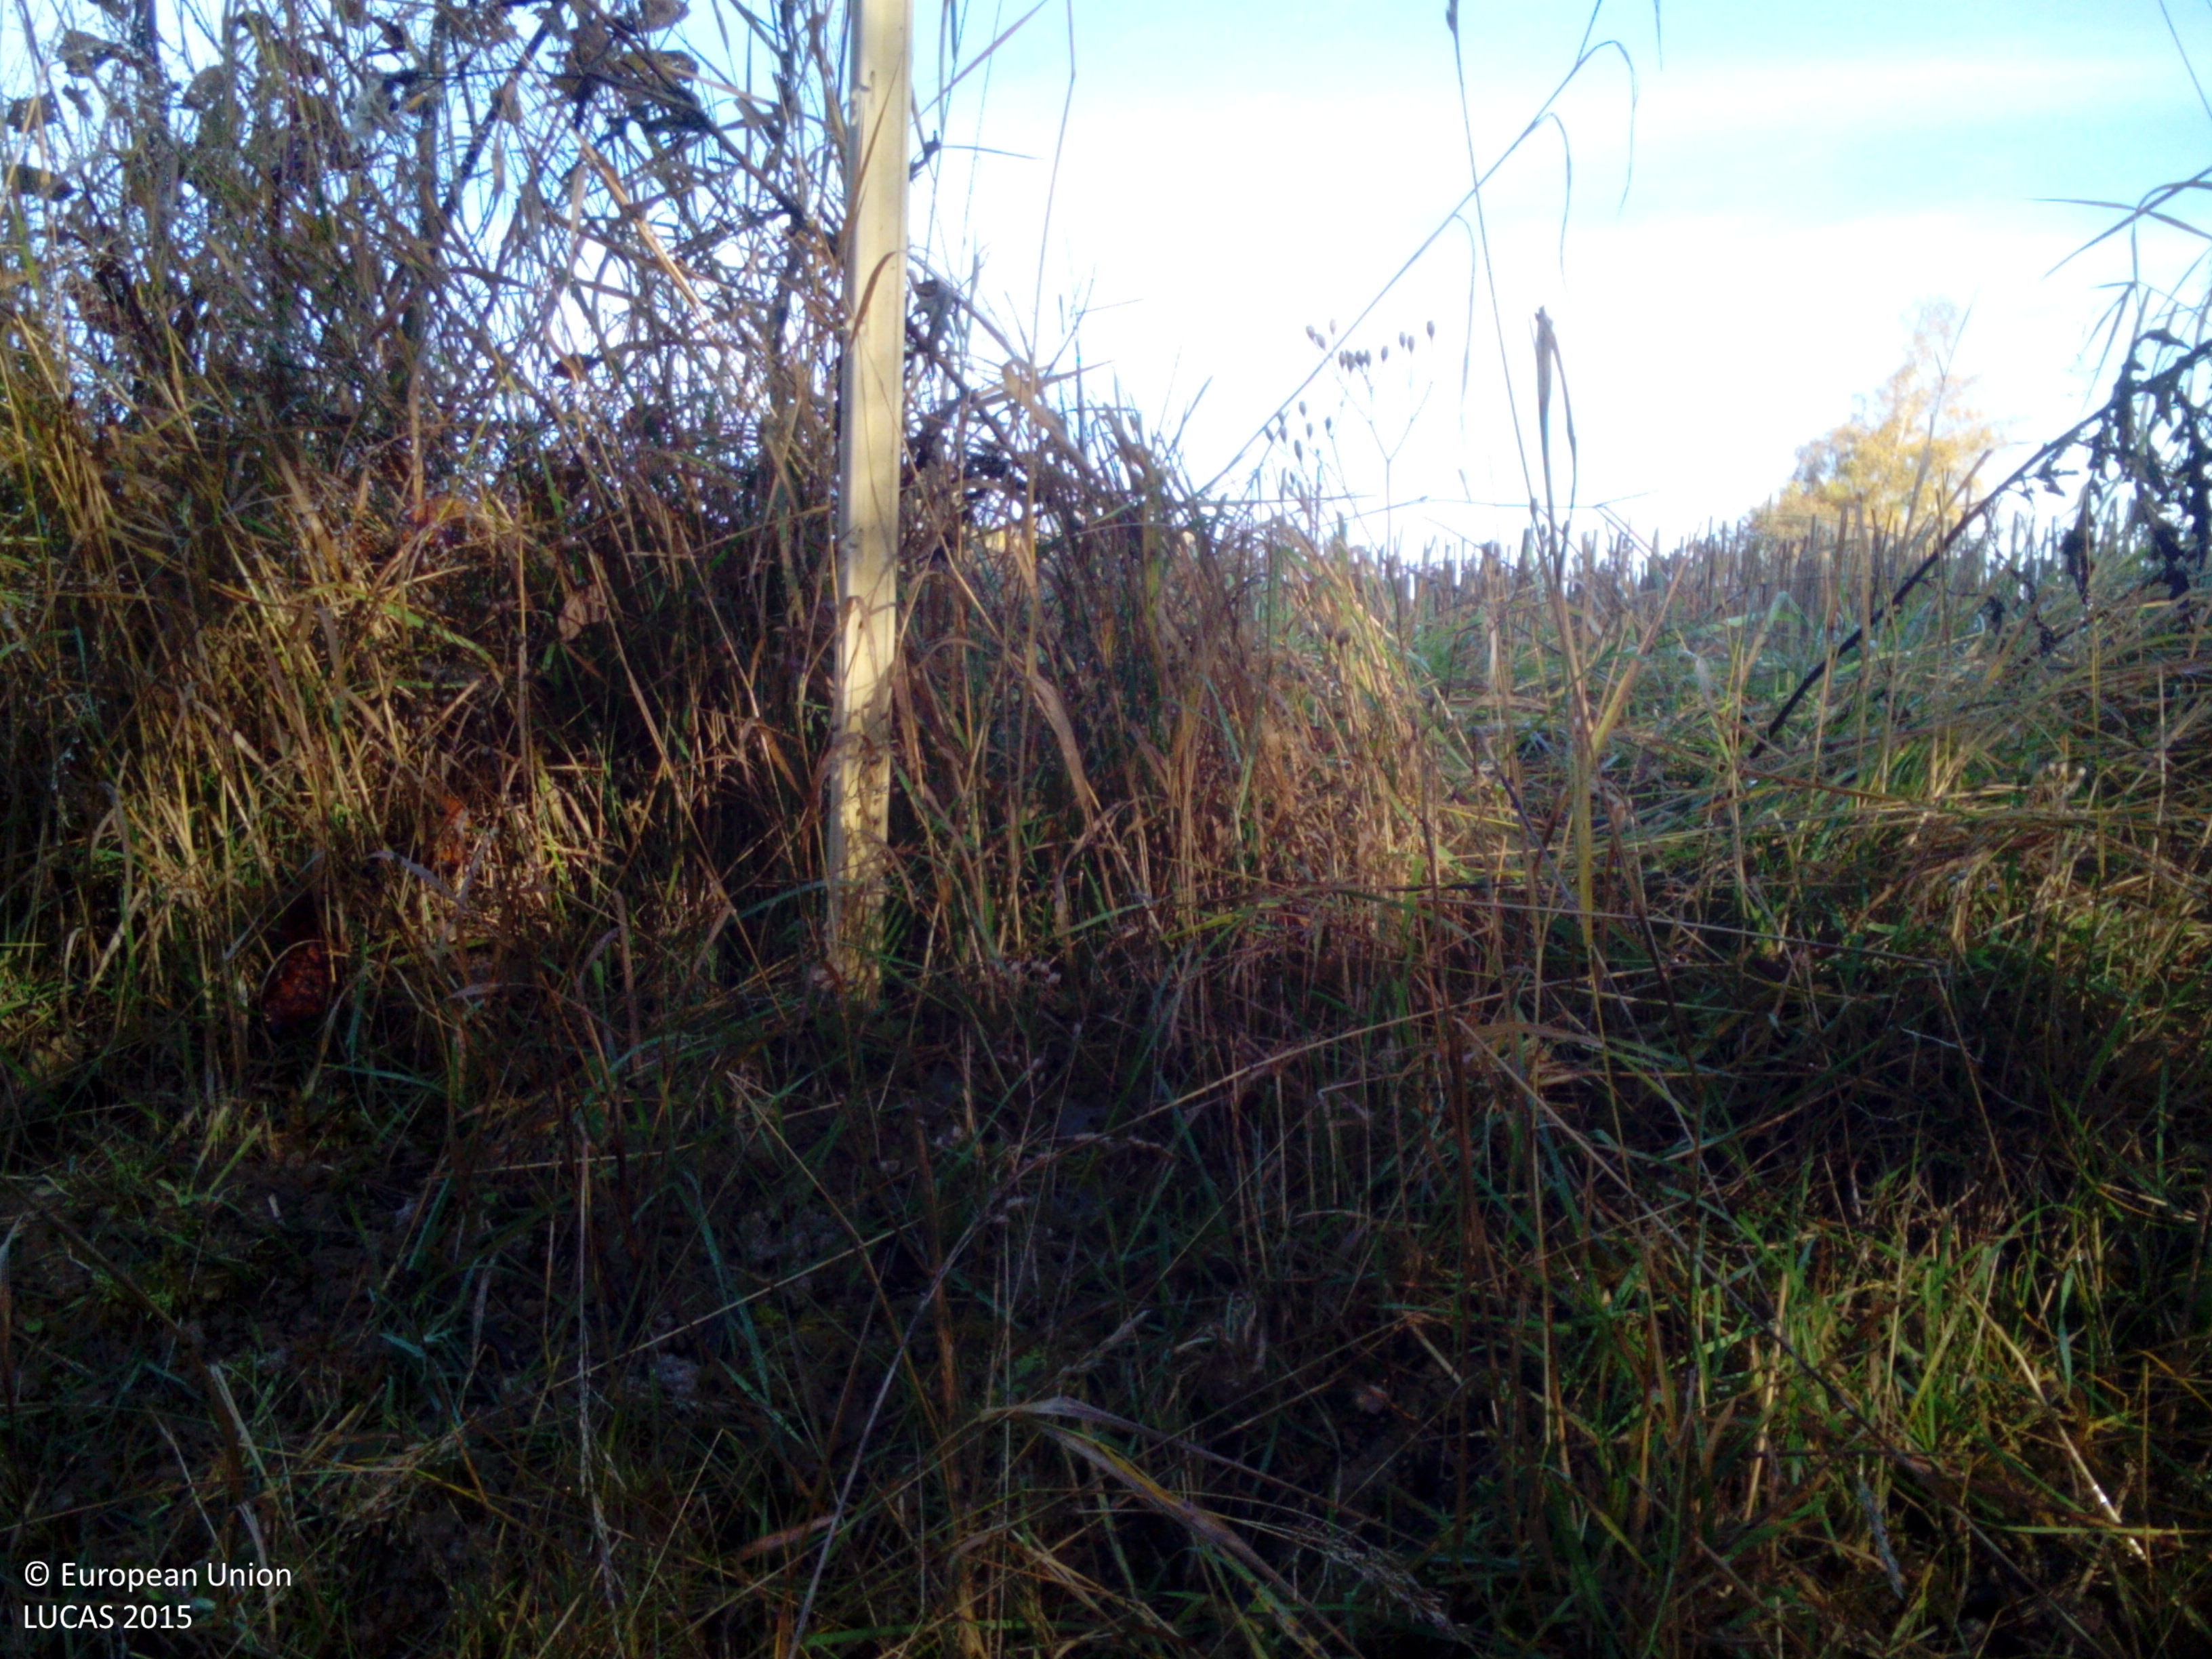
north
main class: Grassland
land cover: Grassland without tree/shrub cover
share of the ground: > 75 %
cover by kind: herbaceous plants 100 %
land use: Agriculture (excluding fallow land and kitchen gardens)
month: October
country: SE
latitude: 59.0831
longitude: 16.2929
